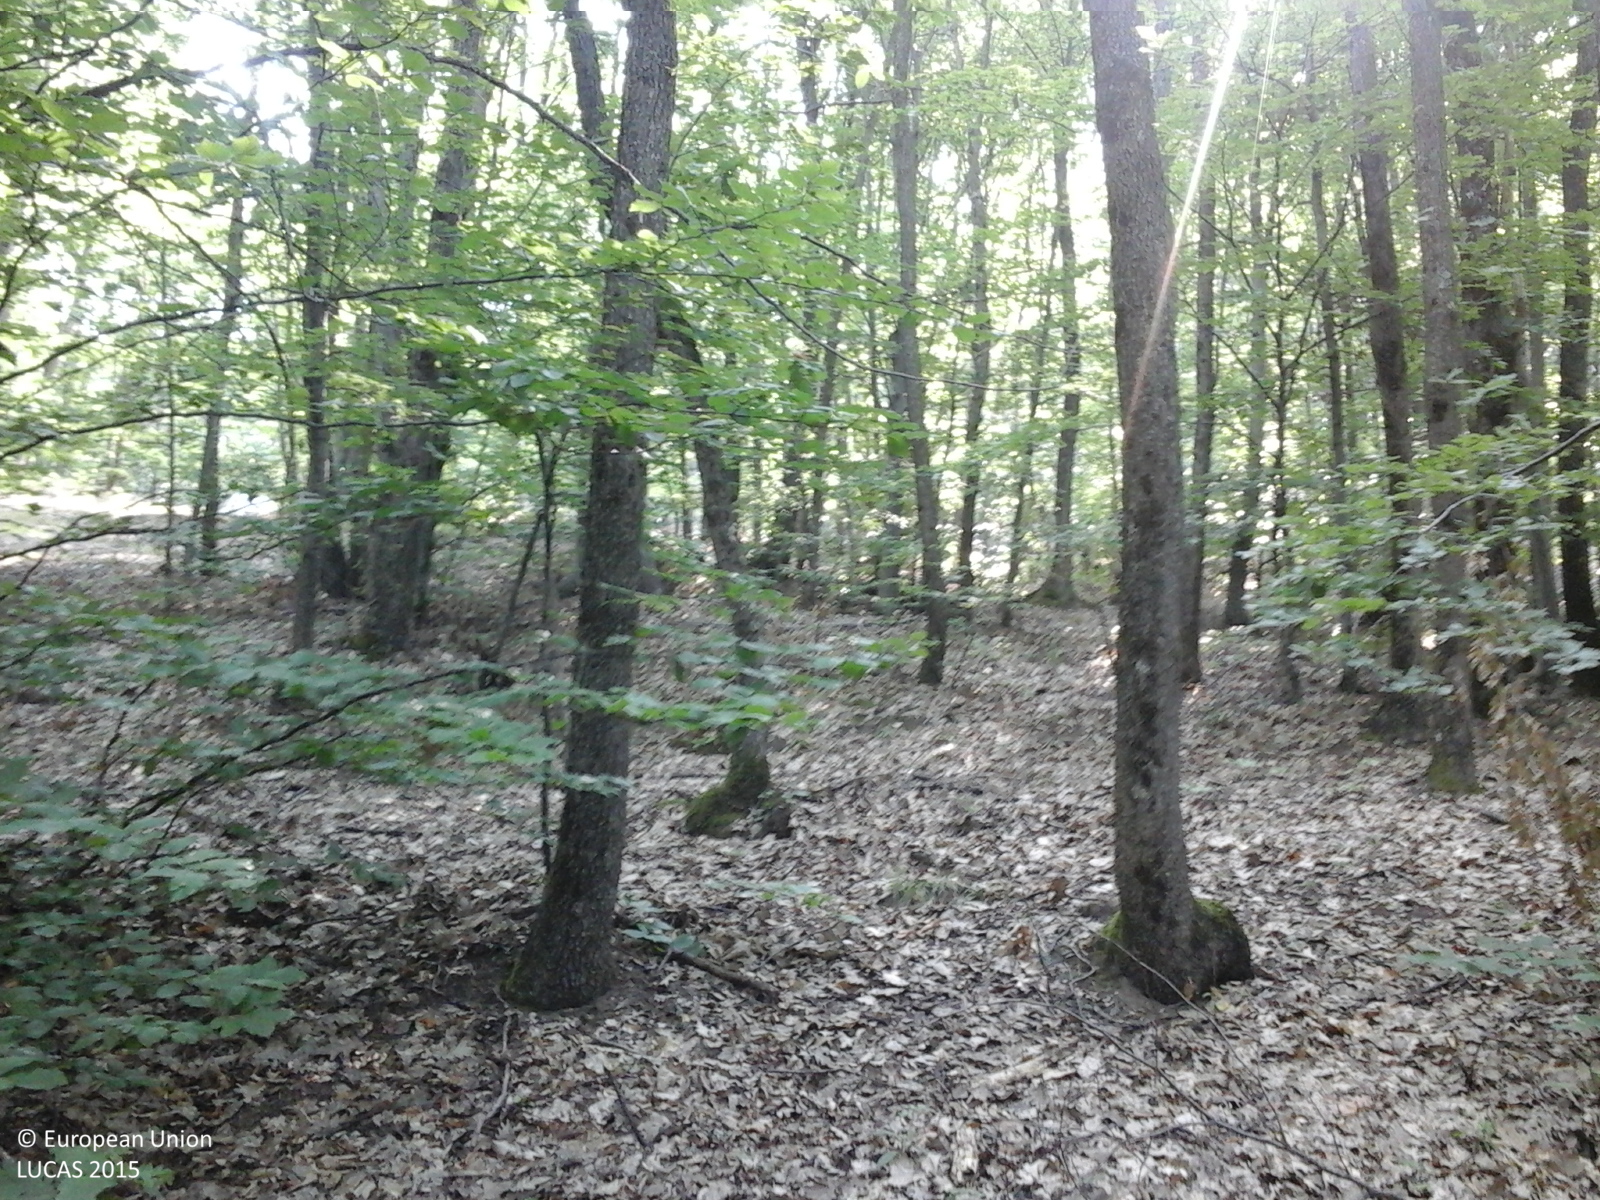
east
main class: Woodland
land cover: Broadleaved woodland
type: acidophilous oak and oak-birch forest
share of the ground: > 75 %
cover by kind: broadleaved forest trees 100 %
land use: Forestry
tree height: > 5 m
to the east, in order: Broadleaved woodland; Tracks; Broadleaved woodland; Tracks; Broadleaved woodland
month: July
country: RO
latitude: 44.9668
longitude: 24.6715
